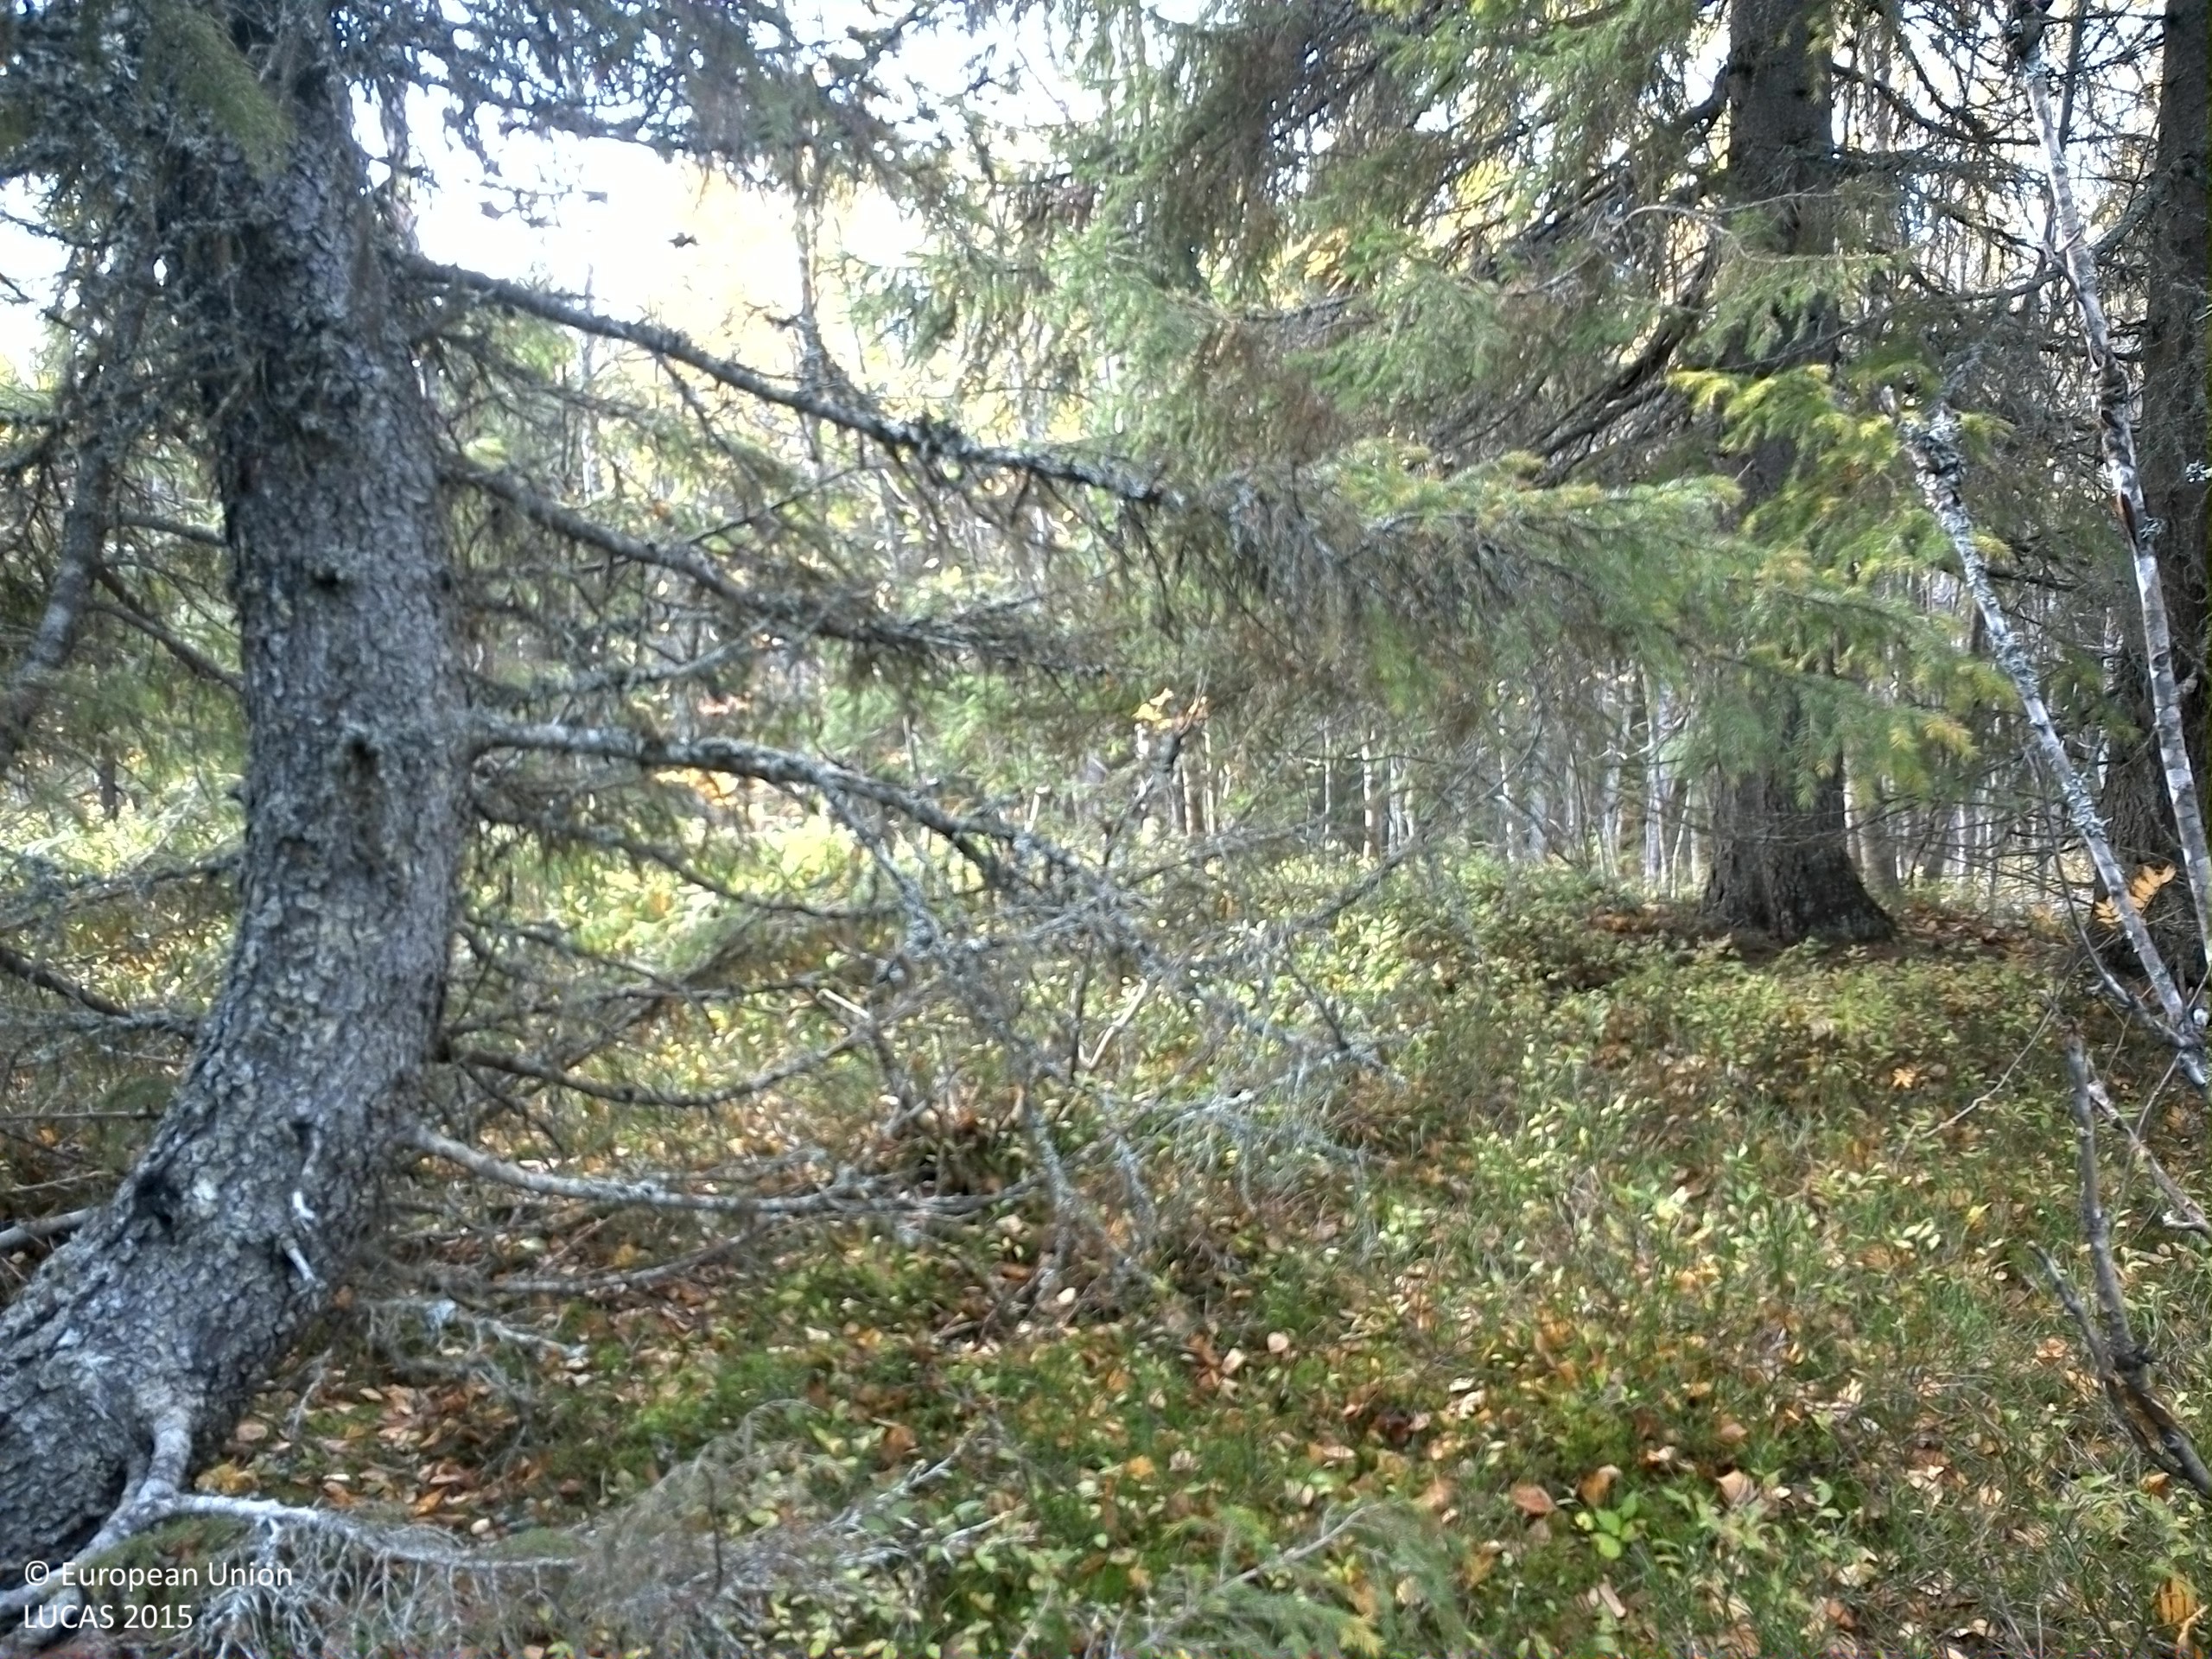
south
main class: Woodland
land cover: Spruce dominated mixed woodland
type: boreal forest
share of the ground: 50 - 75 %
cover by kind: coniferous forest trees 40 %, shrubs 25 %, broadleaved forest trees 15 %, lichens and mosses 15 %, herbaceous plants 5 %
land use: Forestry
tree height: > 5 m
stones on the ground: 10 - 25 %
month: October
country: SE
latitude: 64.3393
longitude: 15.9926
